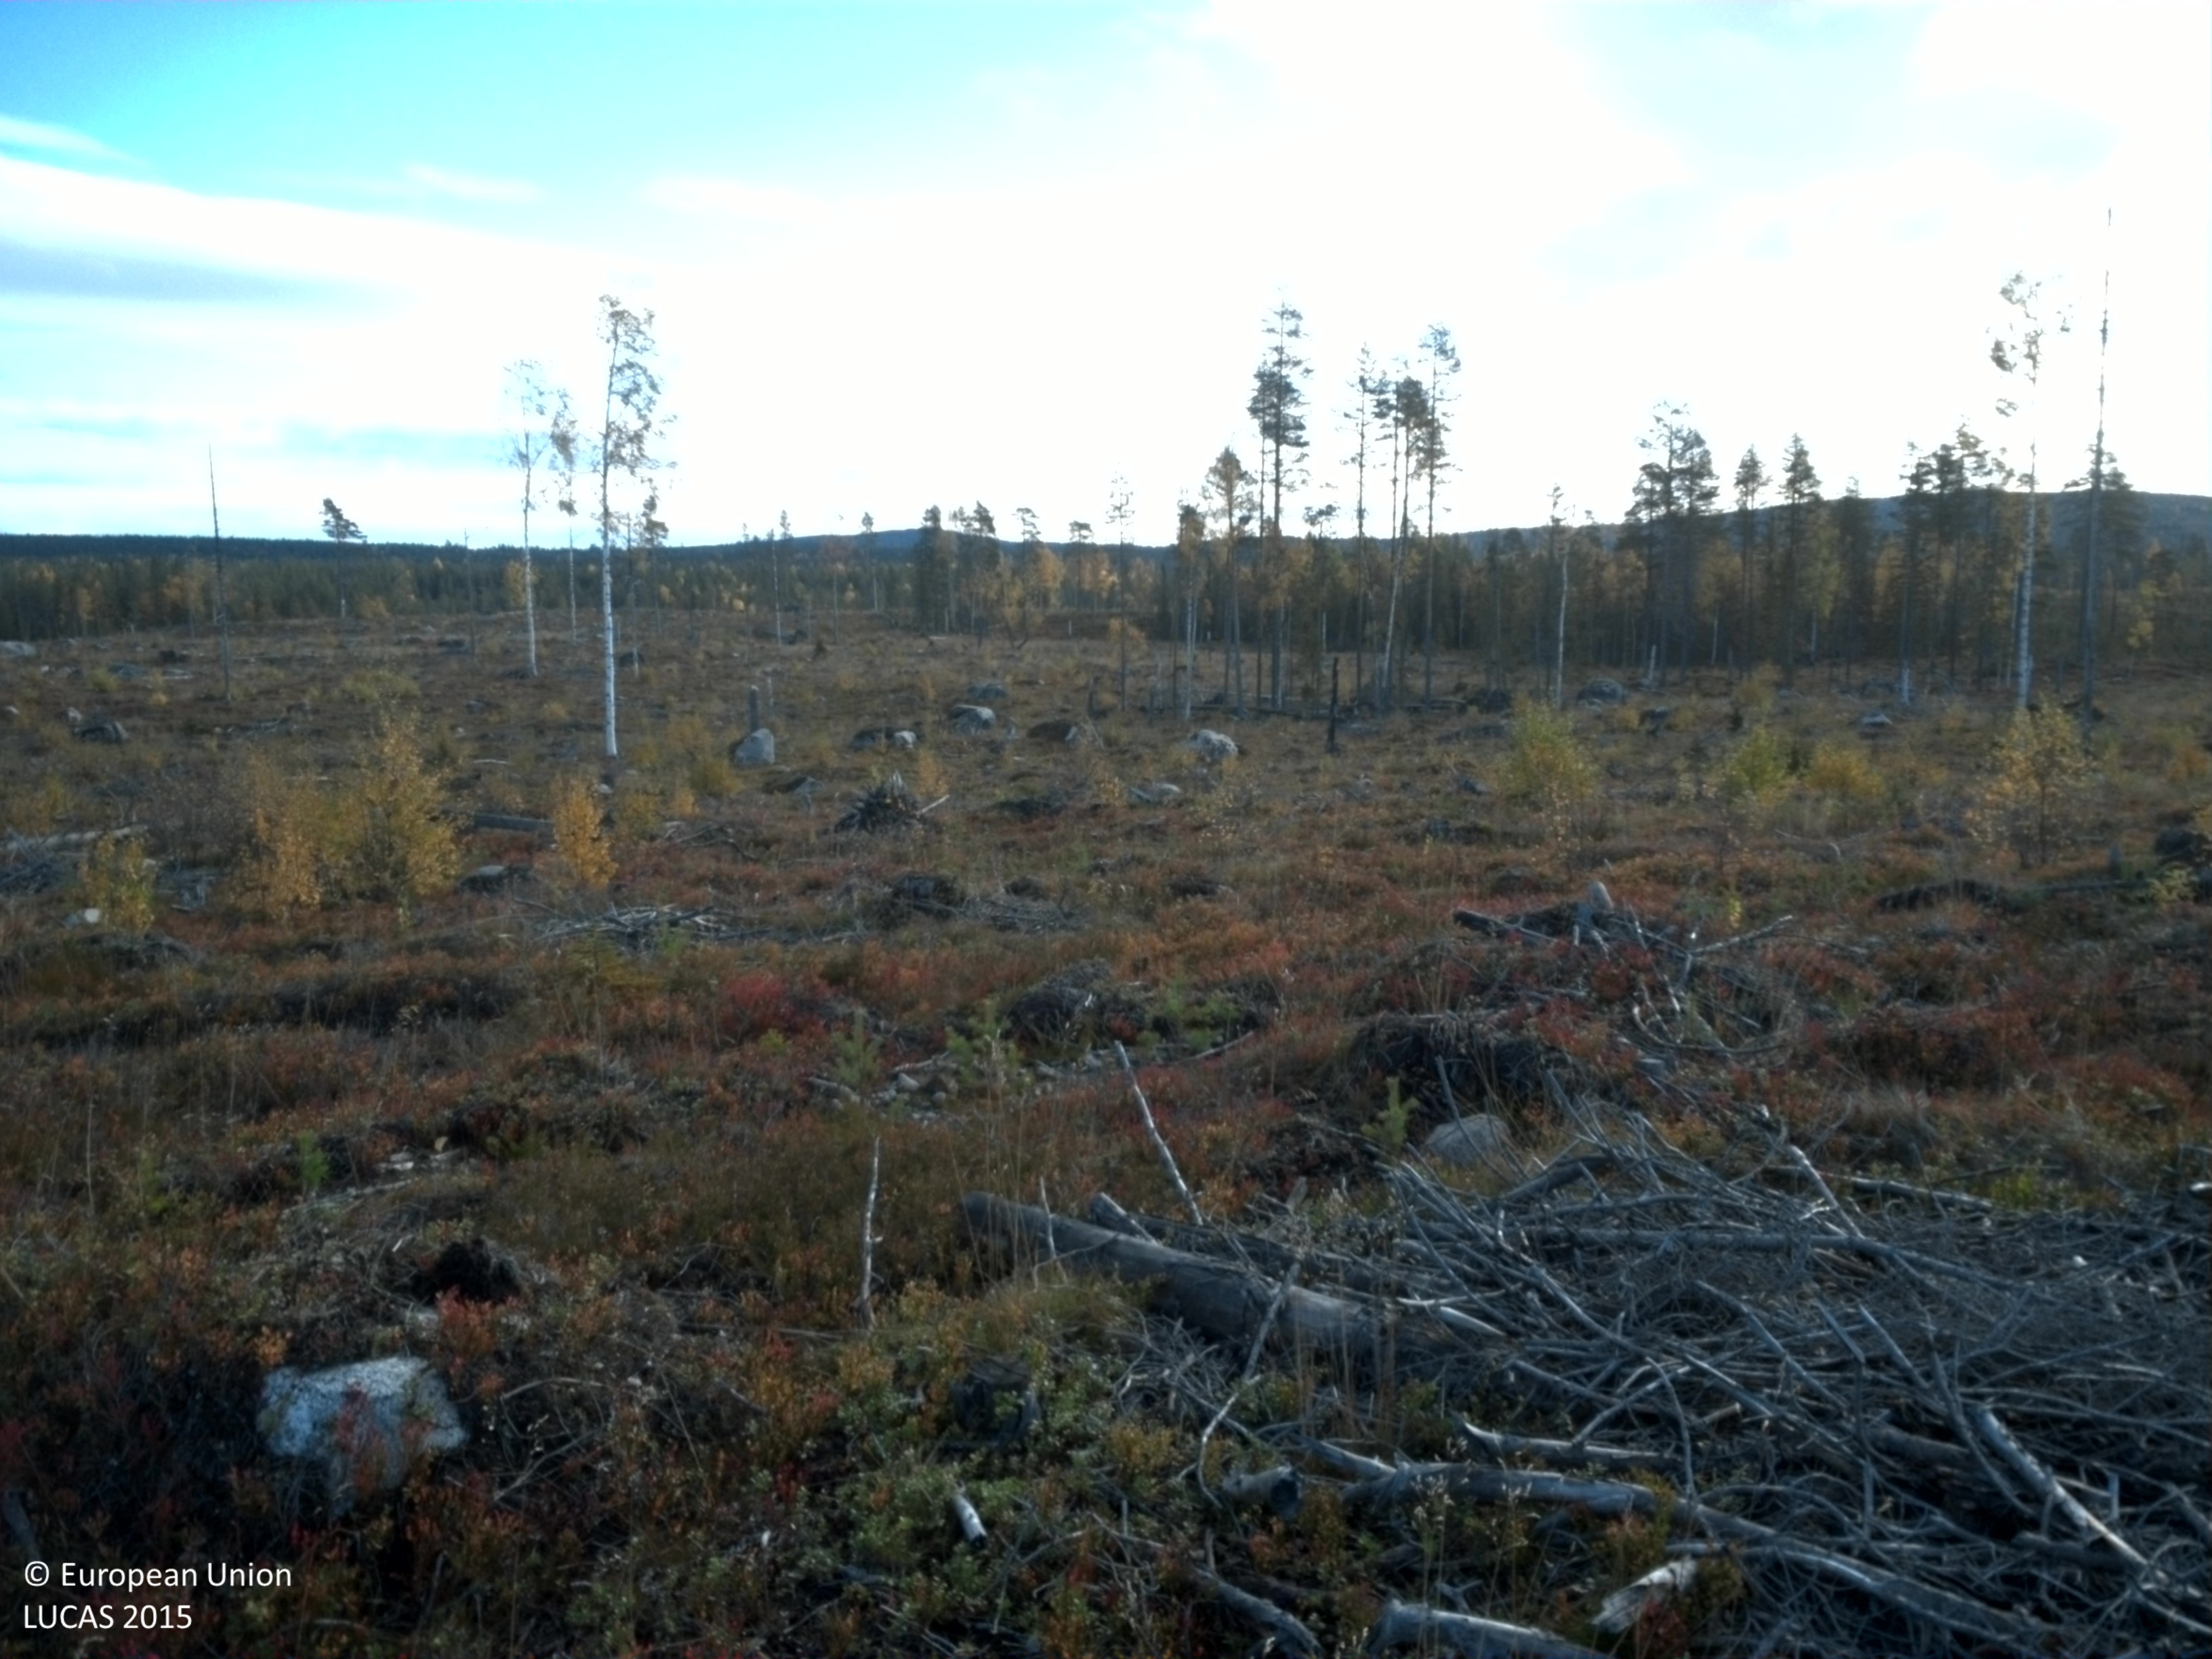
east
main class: Shrubland
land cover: Shrubland without tree cover
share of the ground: 50 - 75 %
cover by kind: shrubs 60 %, herbaceous plants 20 %, unconsolidated bare surface 10 %, lichens and mosses 5 %
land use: Forestry
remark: Clear cut
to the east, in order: Shrubland without tree cover; Shrubland with sparse tree cover; Pine dominated mixed woodland; Shrubland with sparse tree cover
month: September
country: SE
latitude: 65.0198
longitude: 17.8794
